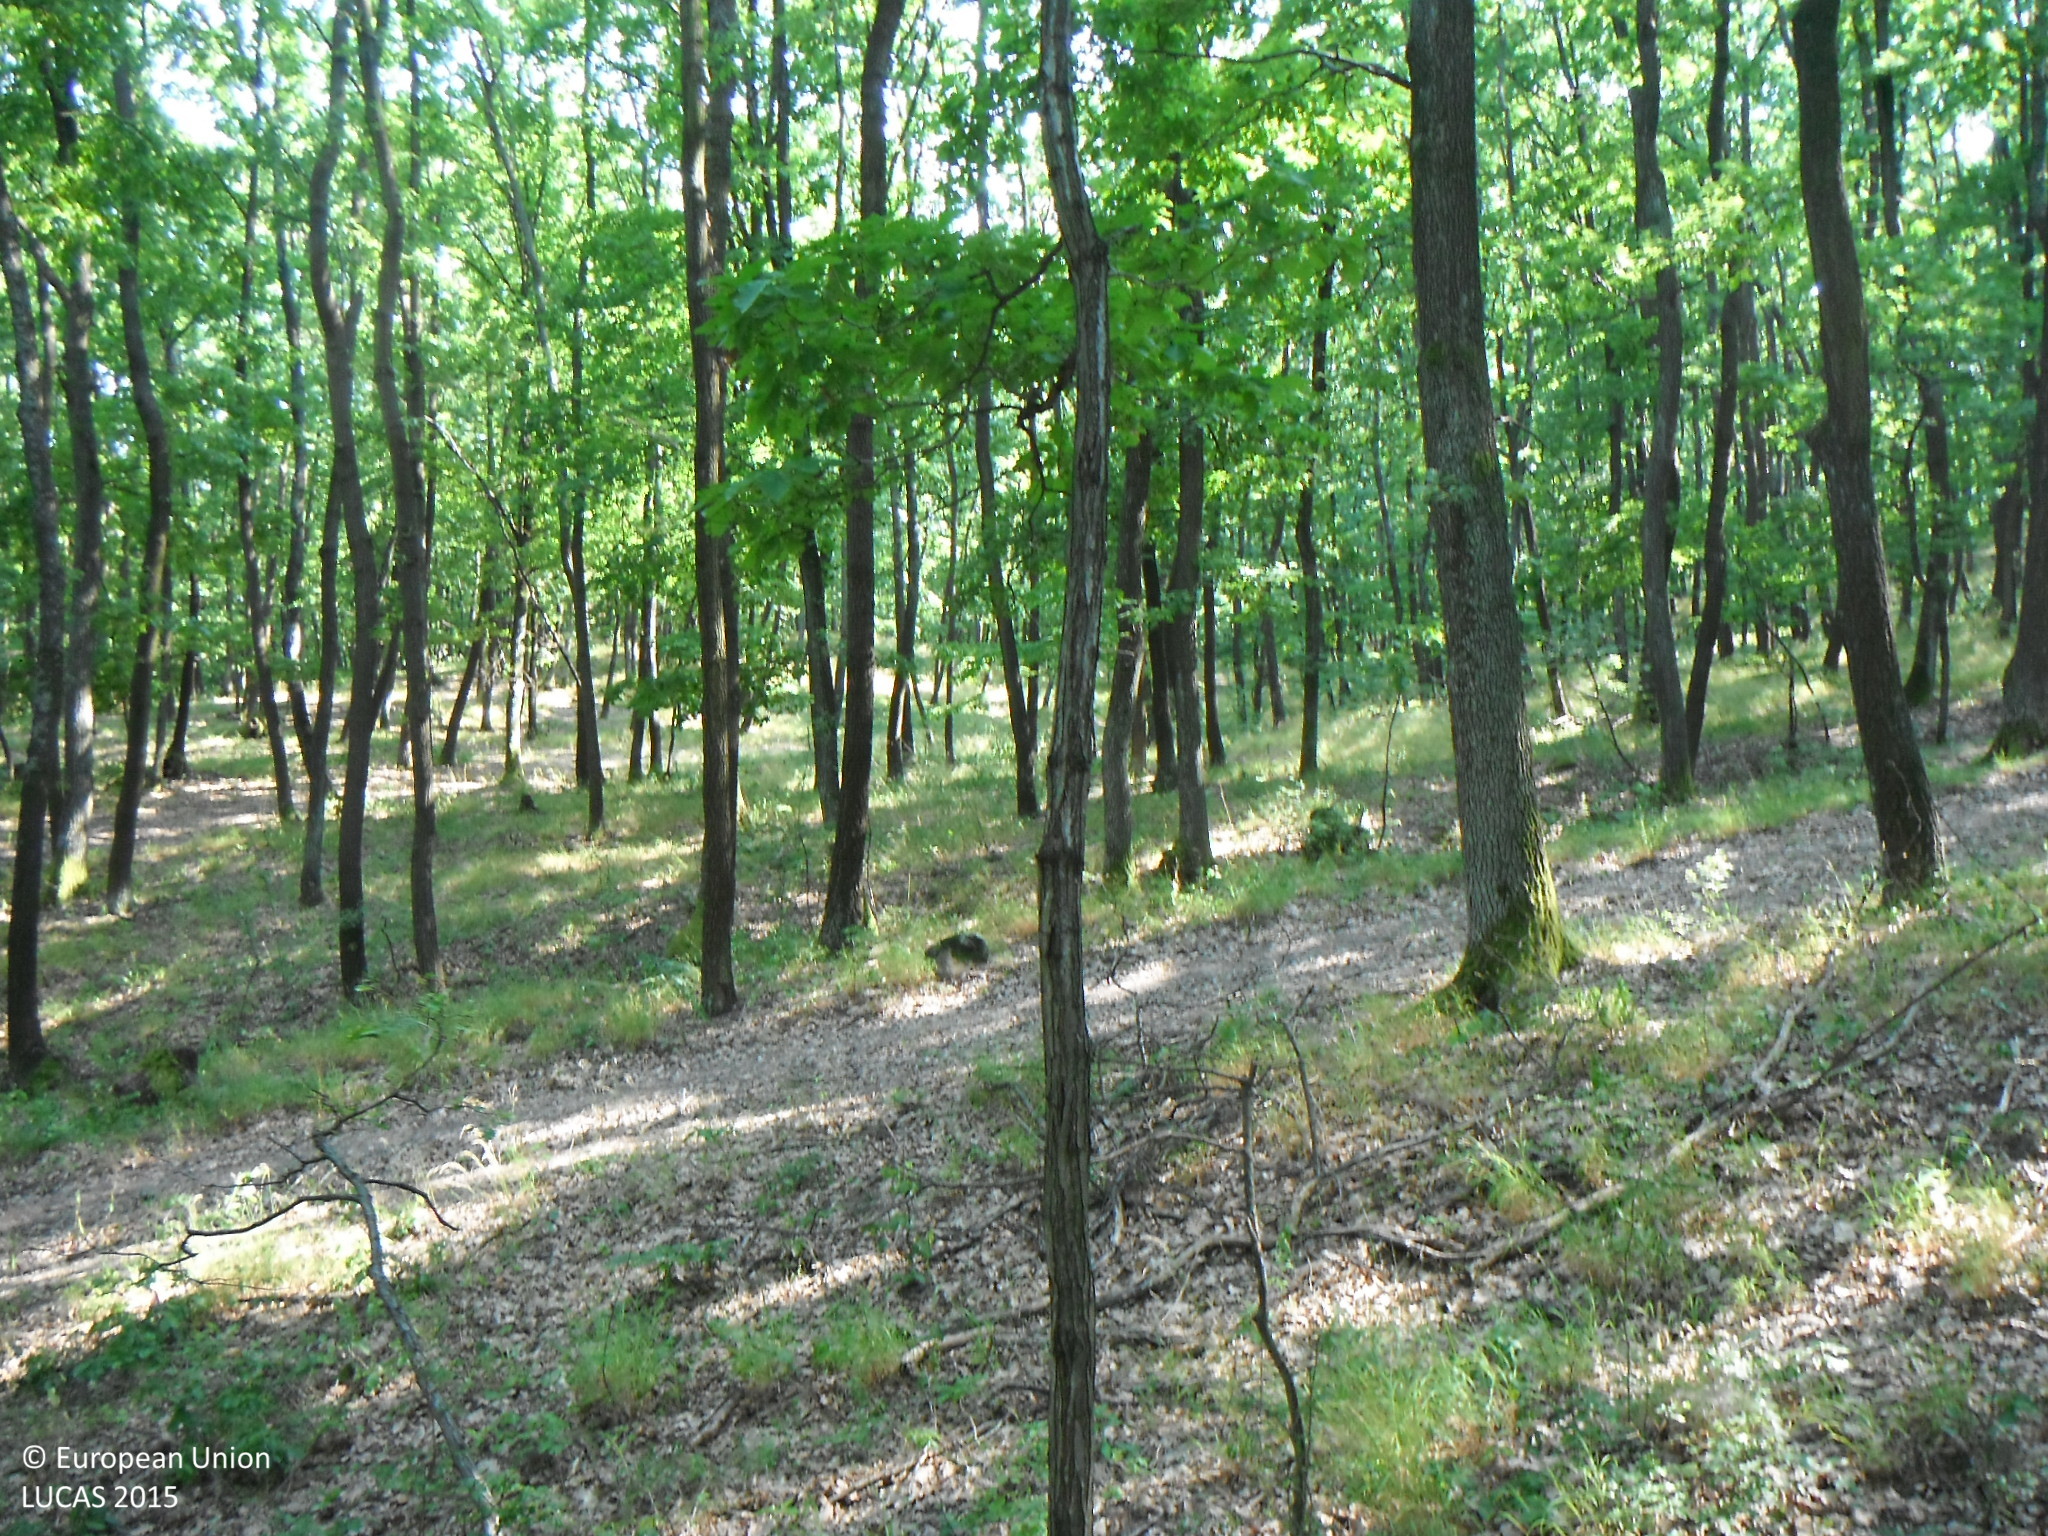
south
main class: Woodland
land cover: Broadleaved woodland
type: acidophilous oak and oak-birch forest
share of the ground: > 75 %
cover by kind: broadleaved forest trees 85 %, herbaceous plants 10 %, shrubs 5 %
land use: Forestry
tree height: > 5 m
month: July
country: SK
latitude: 48.1504
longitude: 19.1477
